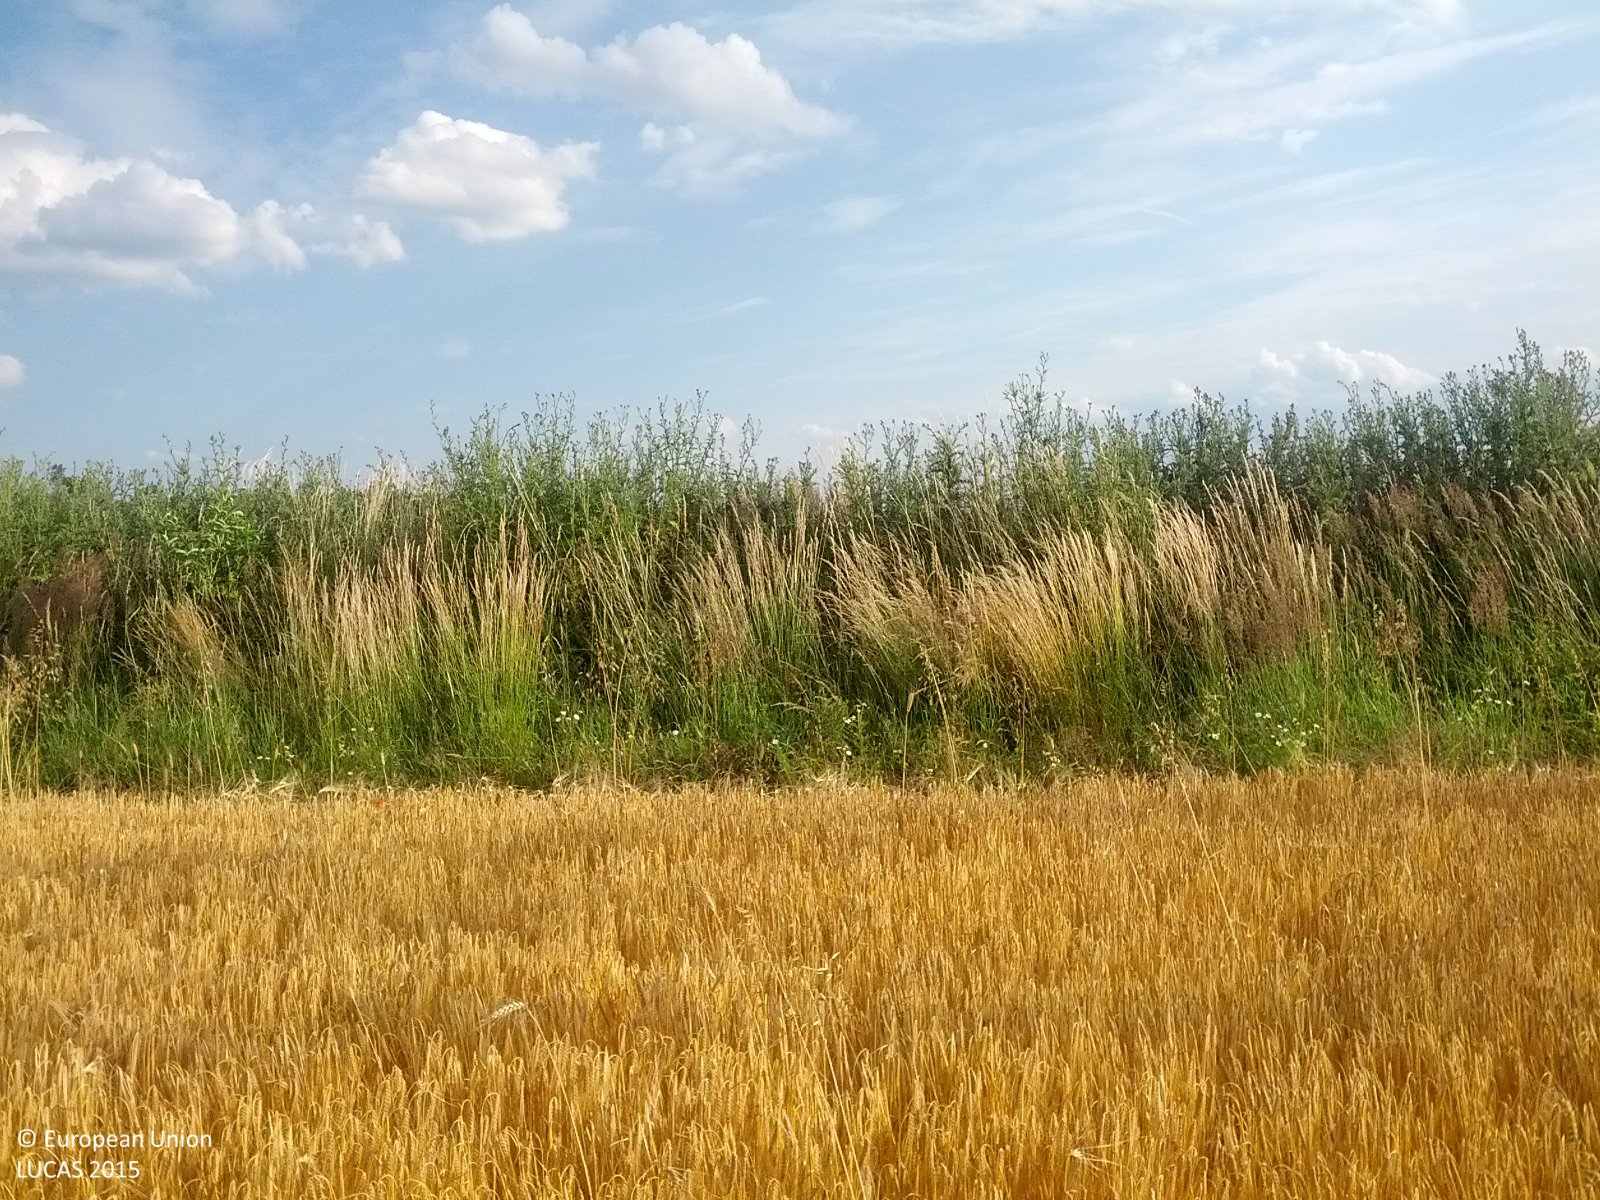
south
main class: Cropland
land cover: Barley
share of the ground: > 75 %
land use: Agriculture (excluding fallow land and kitchen gardens)
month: June
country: AT
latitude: 48.3472
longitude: 16.6585
